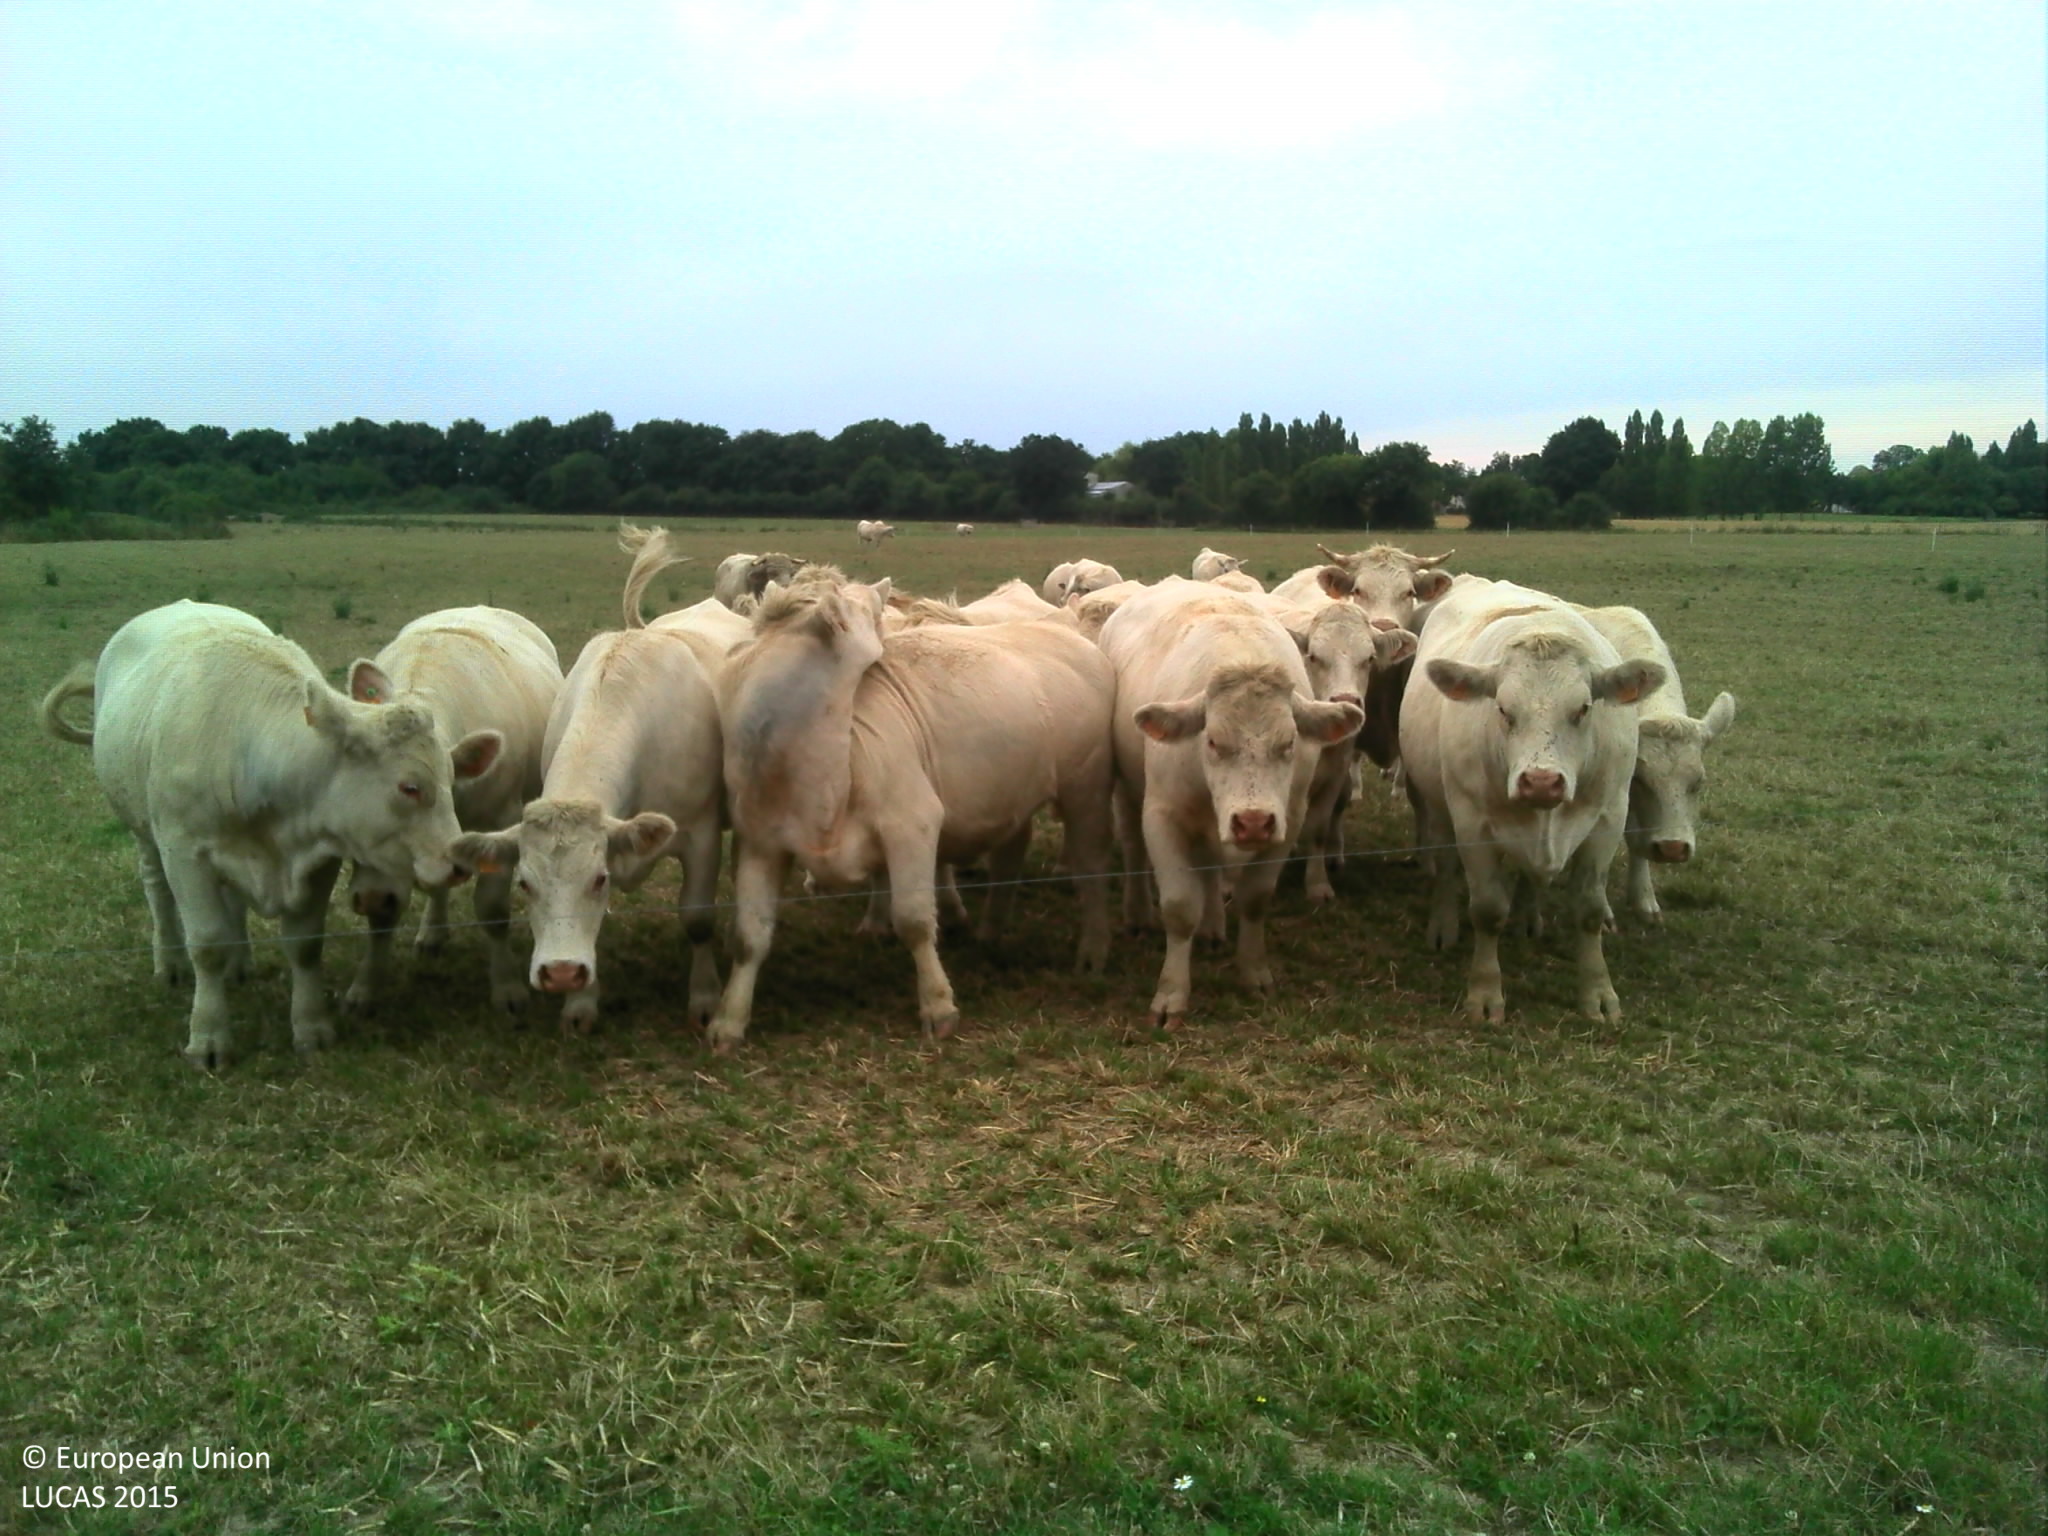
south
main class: Cropland
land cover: Temporary grasslands
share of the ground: > 75 %
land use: Agriculture (excluding fallow land and kitchen gardens)
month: July
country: FR
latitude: 46.8162
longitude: -1.1891
